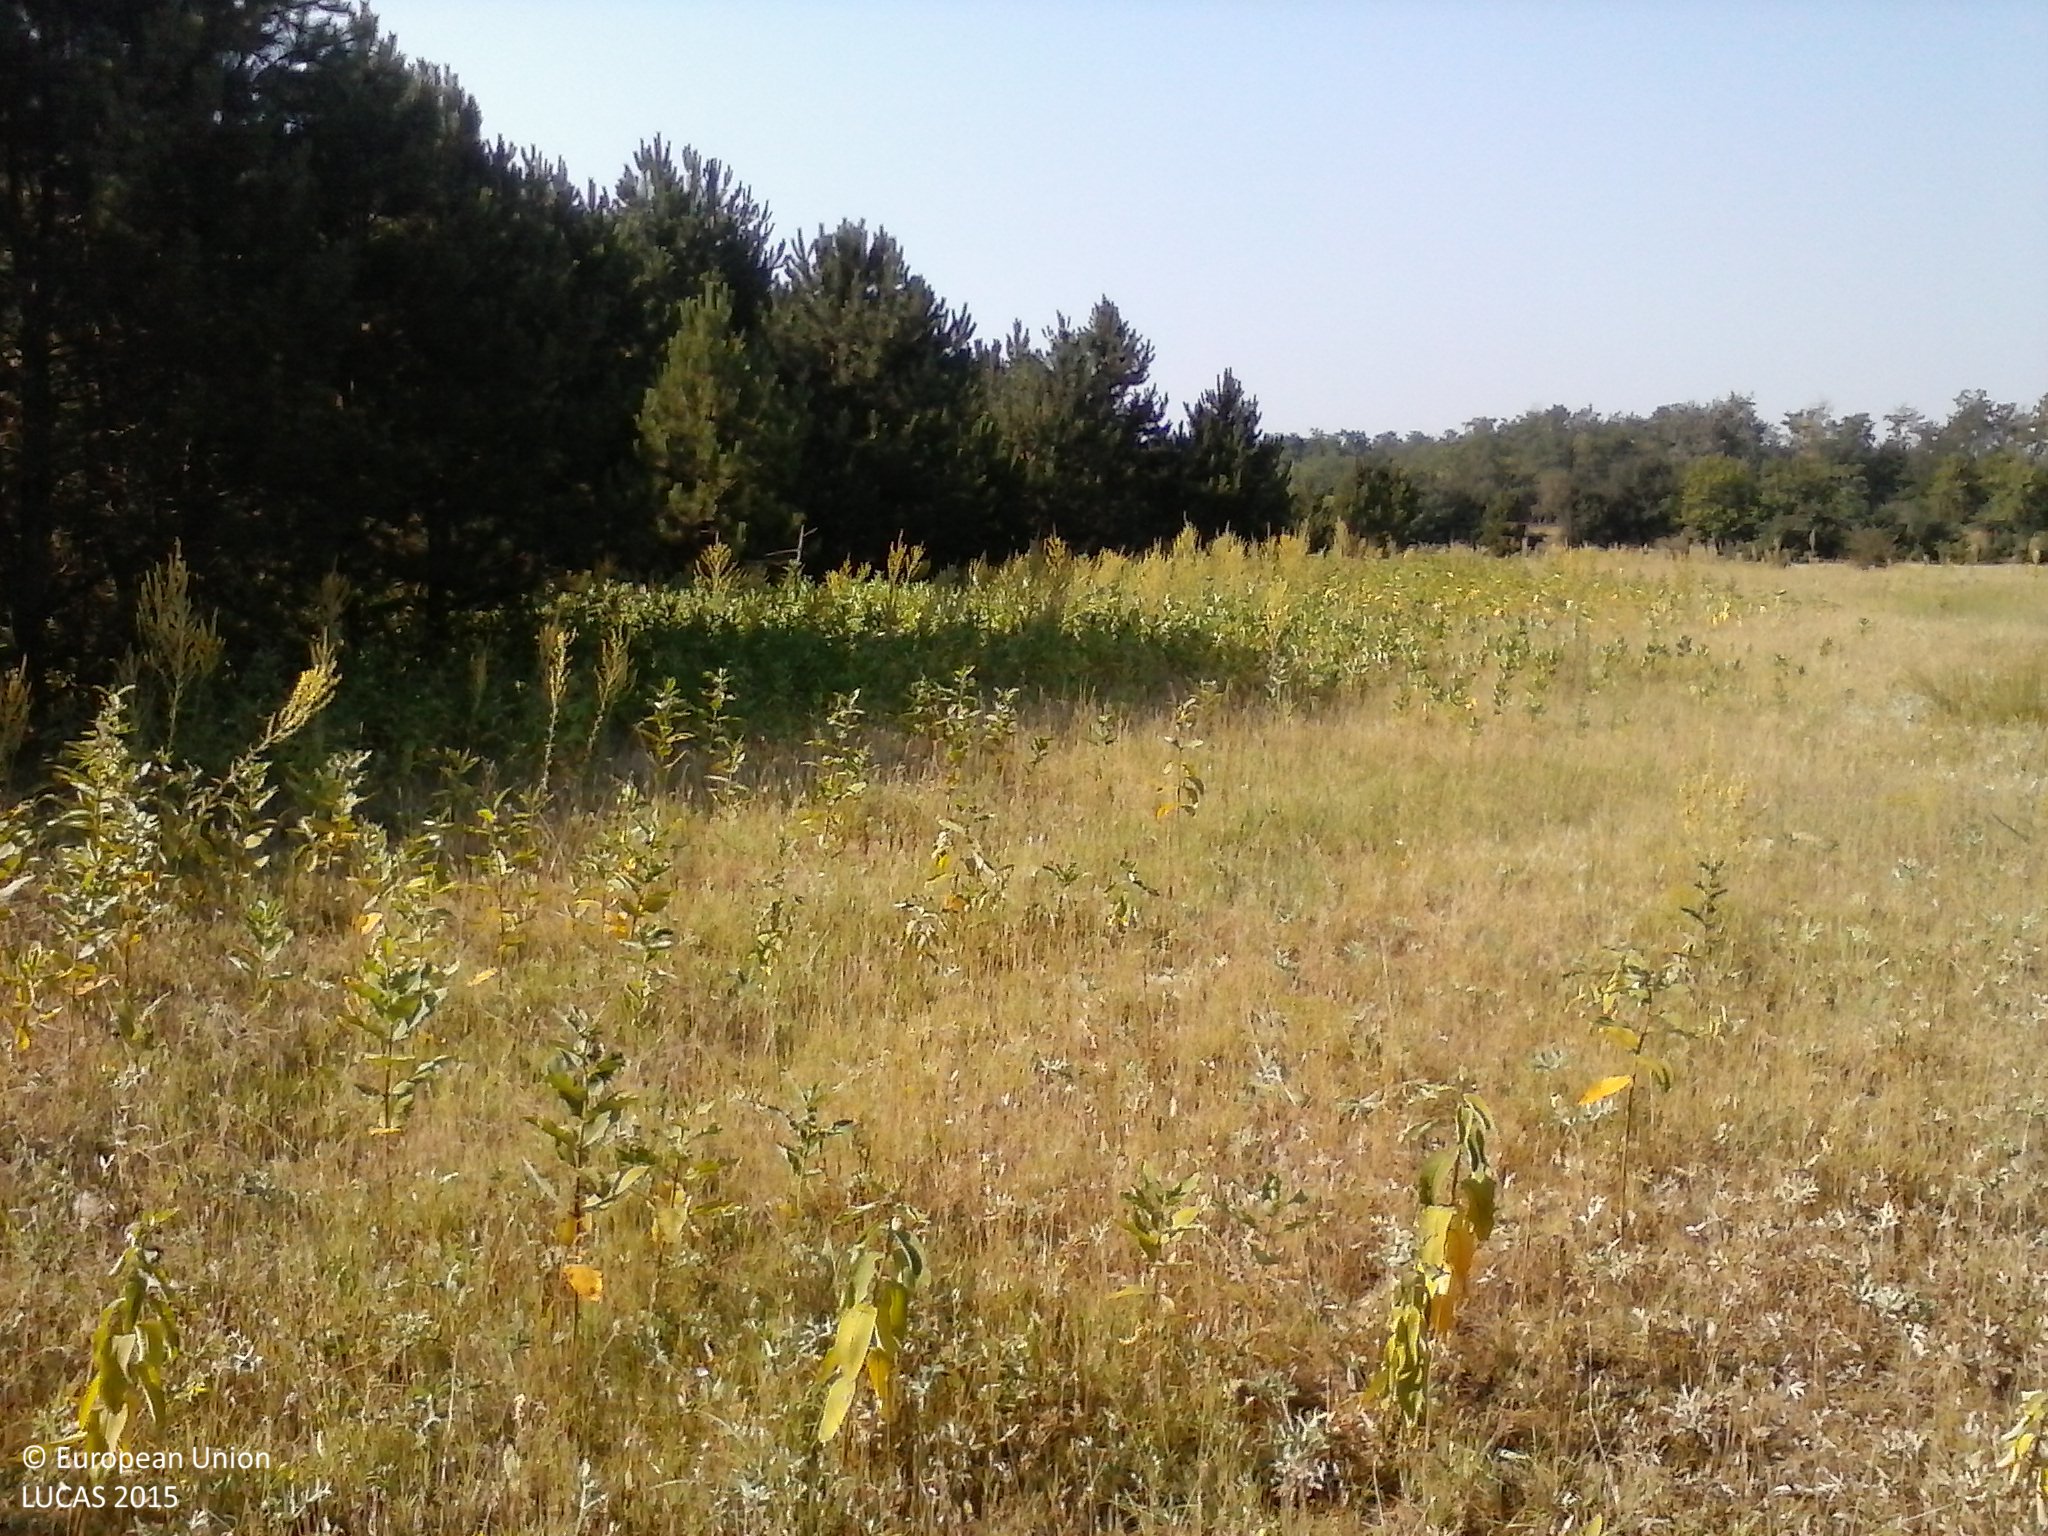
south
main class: Grassland
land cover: Spontaneously vegetated surfaces
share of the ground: > 75 %
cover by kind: herbaceous plants 100 %
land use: Agriculture (excluding fallow land and kitchen gardens)
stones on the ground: < 10 %
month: July
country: HU
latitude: 46.4363
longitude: 19.6889
